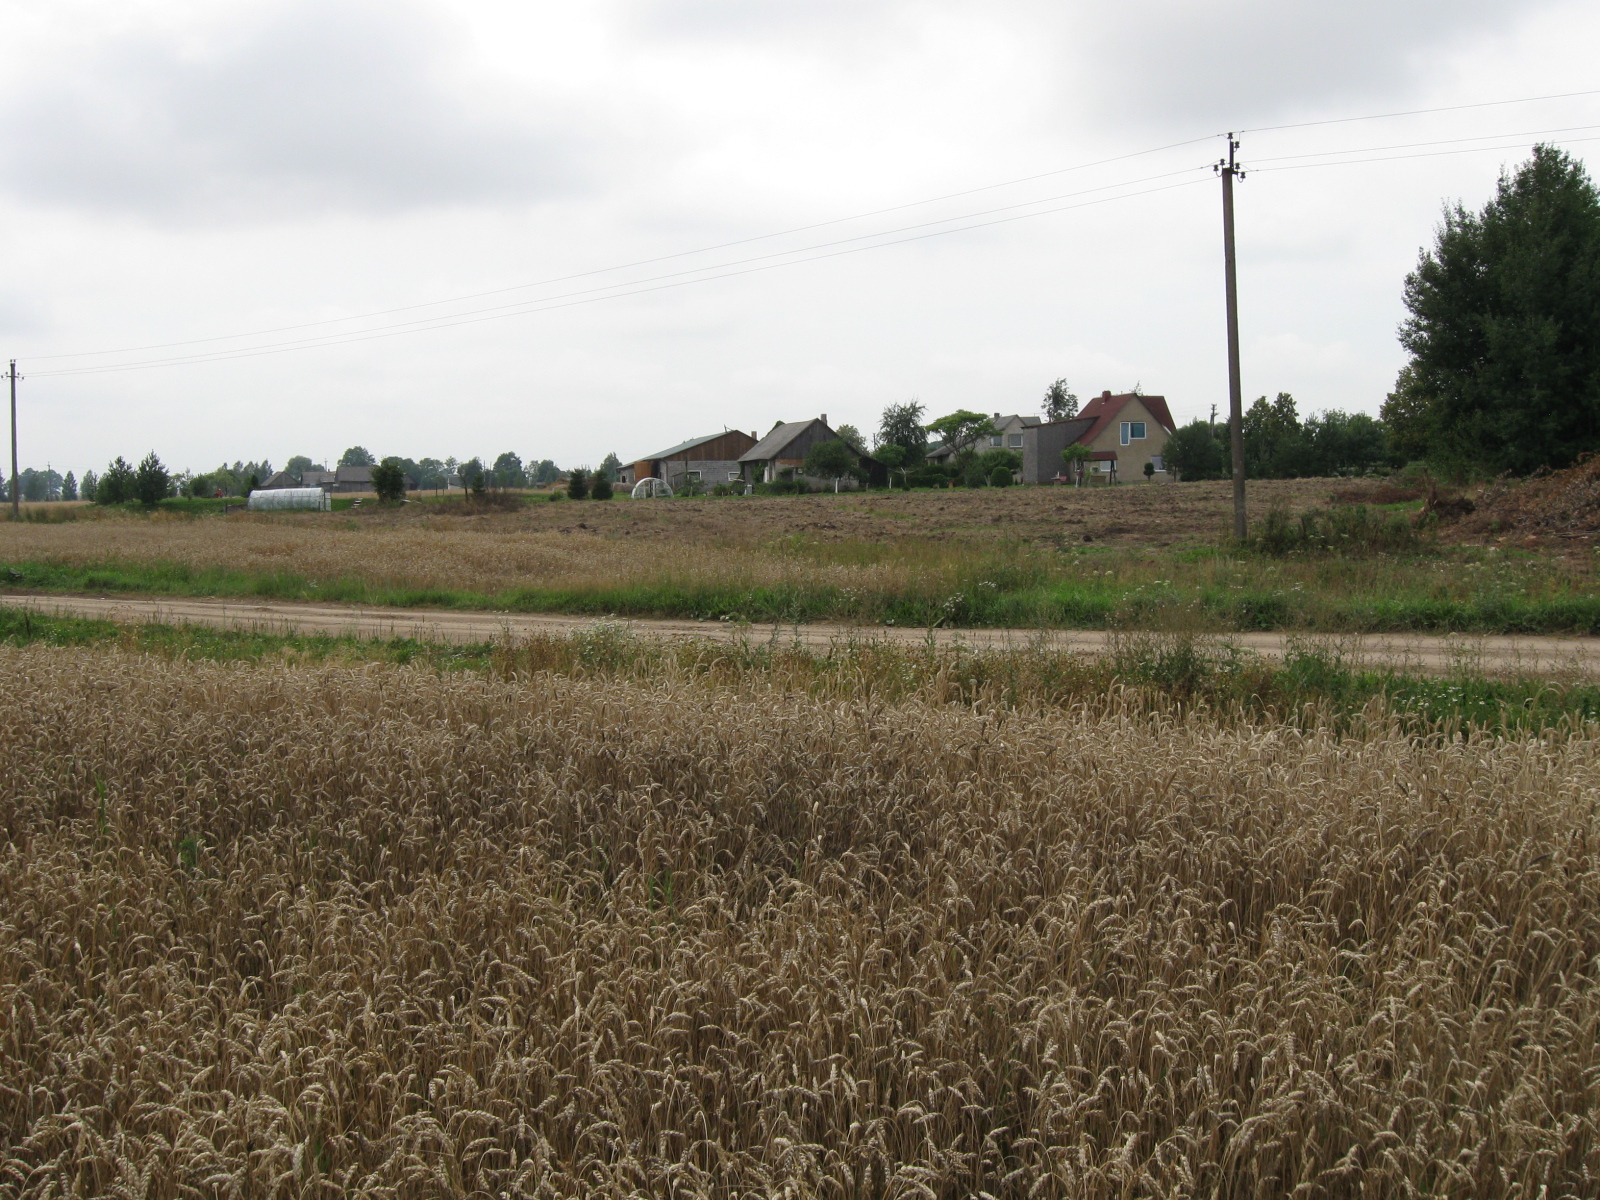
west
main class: Cropland
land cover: Common wheat
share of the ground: > 75 %
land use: Agriculture (excluding fallow land and kitchen gardens)
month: August
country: LT
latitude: 54.6465
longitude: 23.5177
